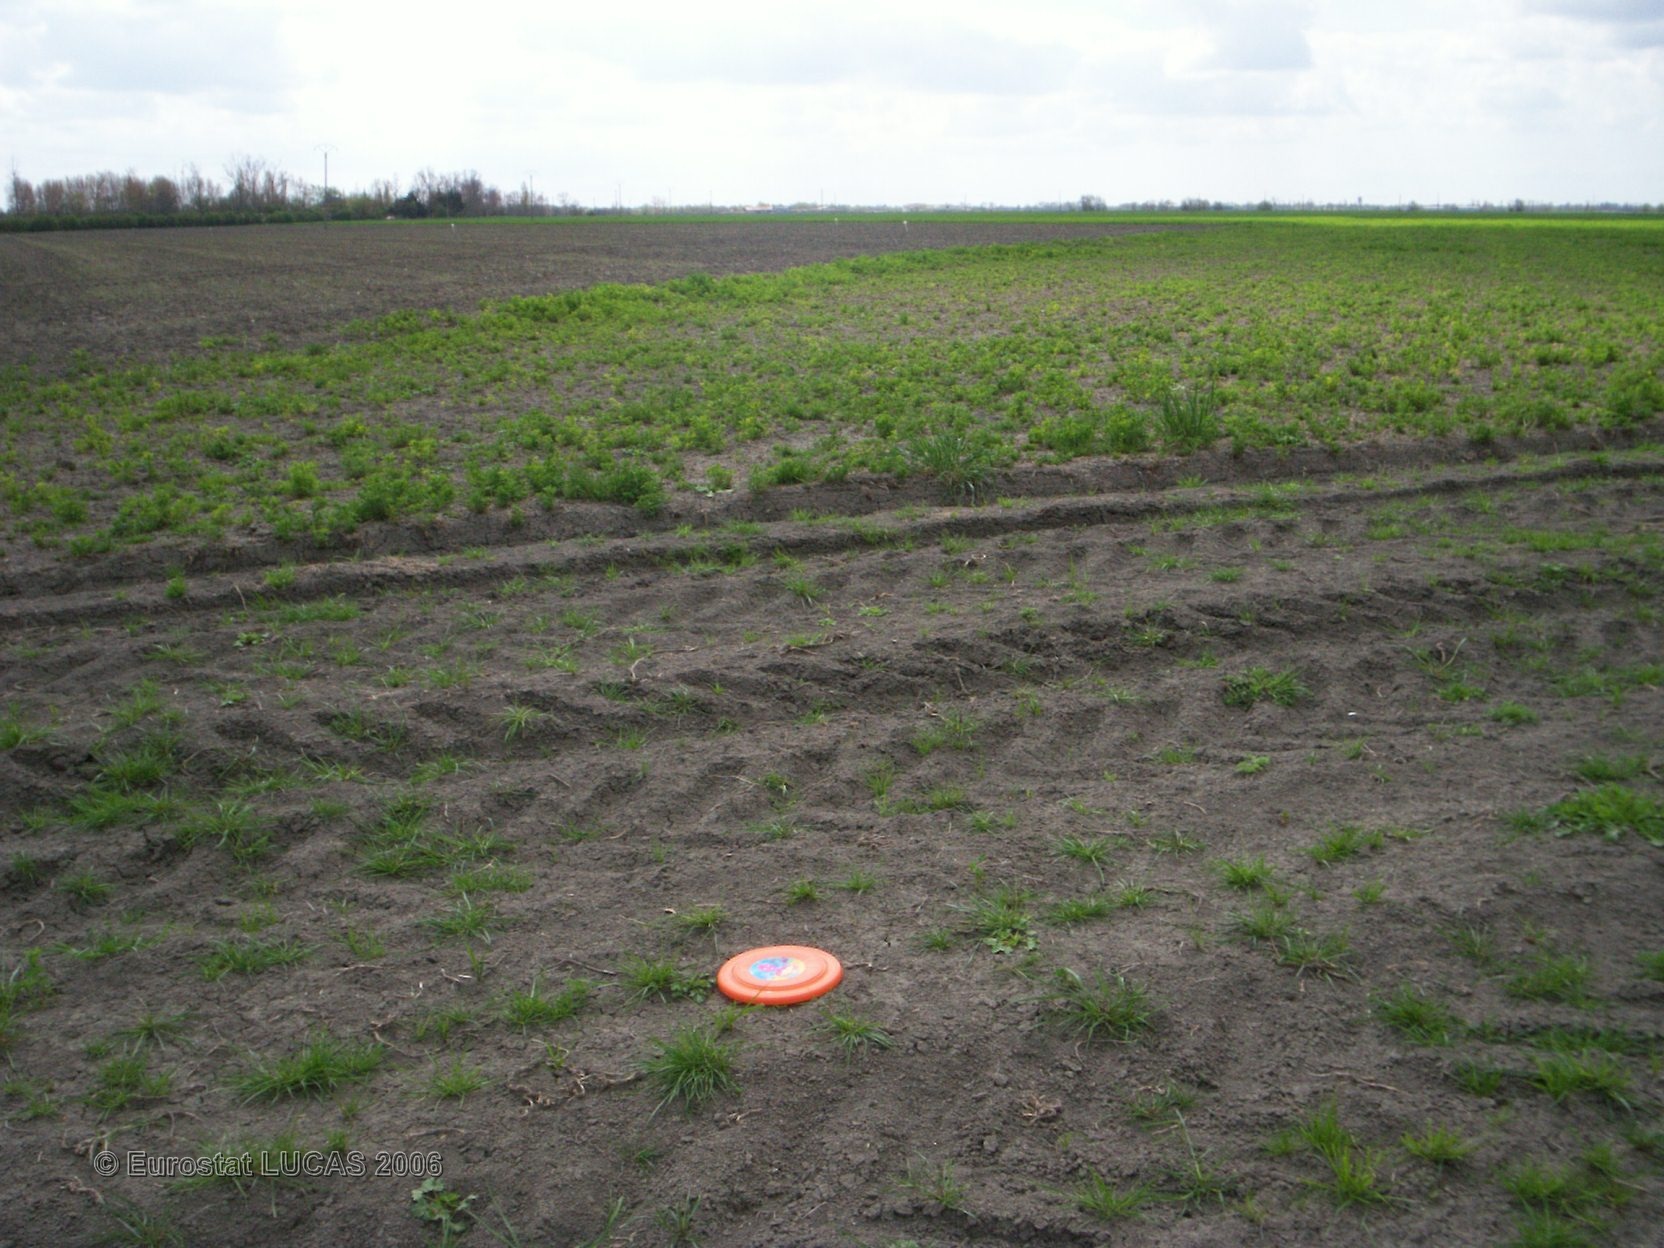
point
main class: Grassland
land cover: Grassland without tree/shrub cover
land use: Fallow land
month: April
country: FR
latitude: 46.3496
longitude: -0.9590
